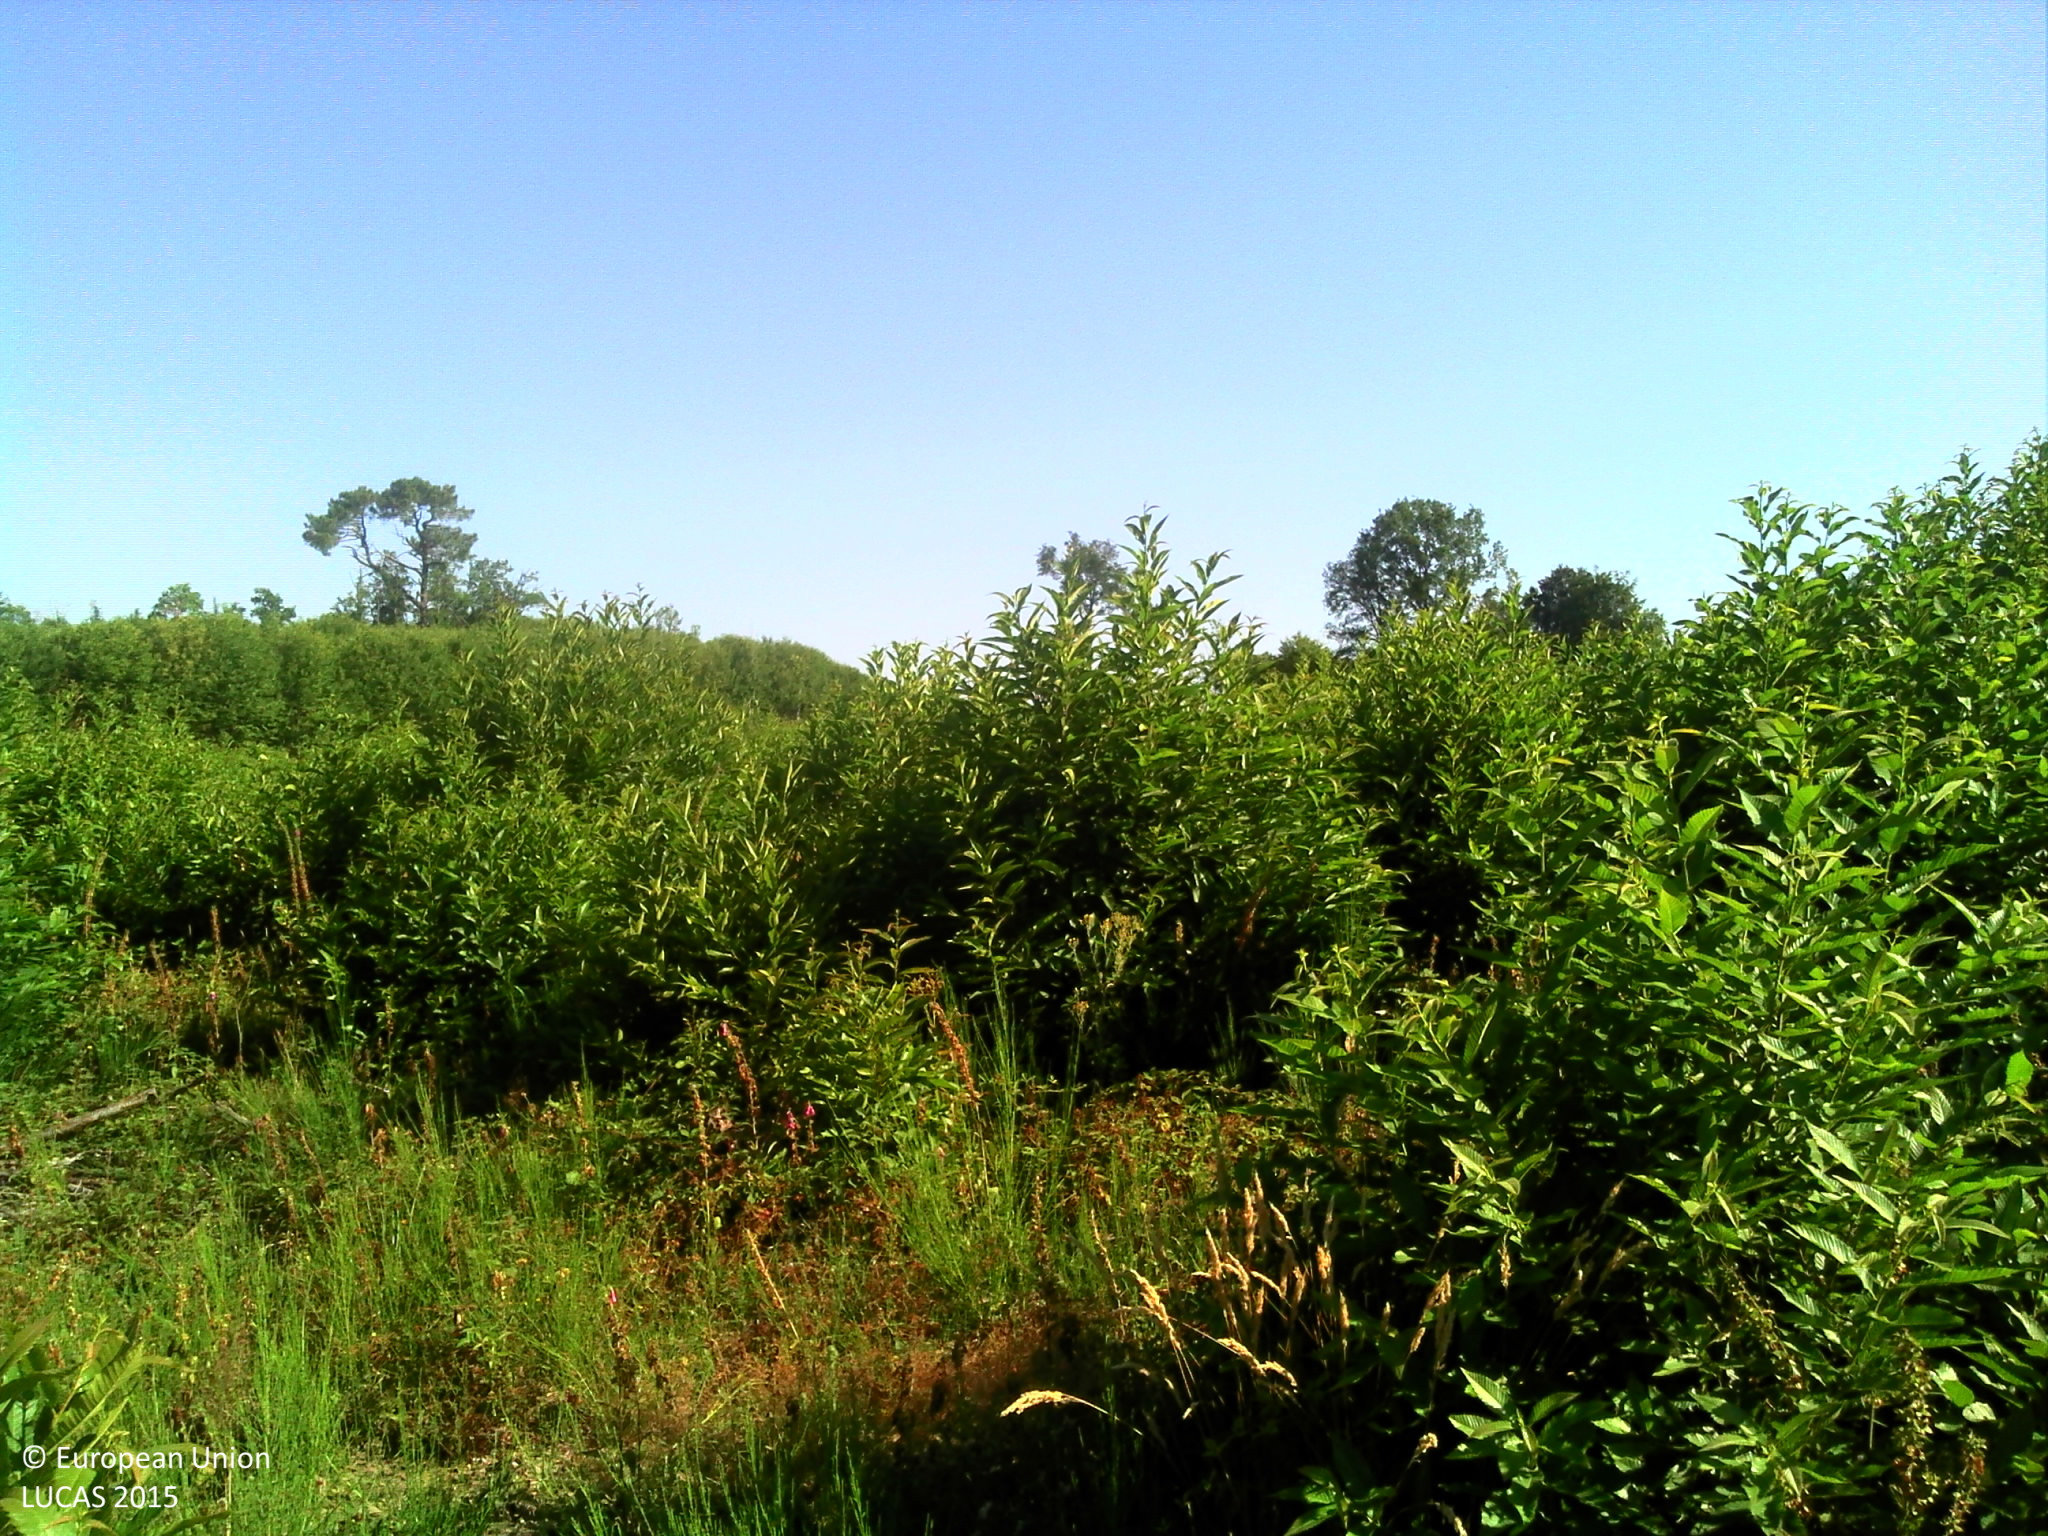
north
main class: Shrubland
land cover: Shrubland with sparse tree cover
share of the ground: > 75 %
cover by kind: shrubs 90 %, broadleaved forest trees 5 %, herbaceous plants 5 %
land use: Forestry
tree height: < 5 m
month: July
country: FR
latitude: 46.1999
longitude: 1.5808
